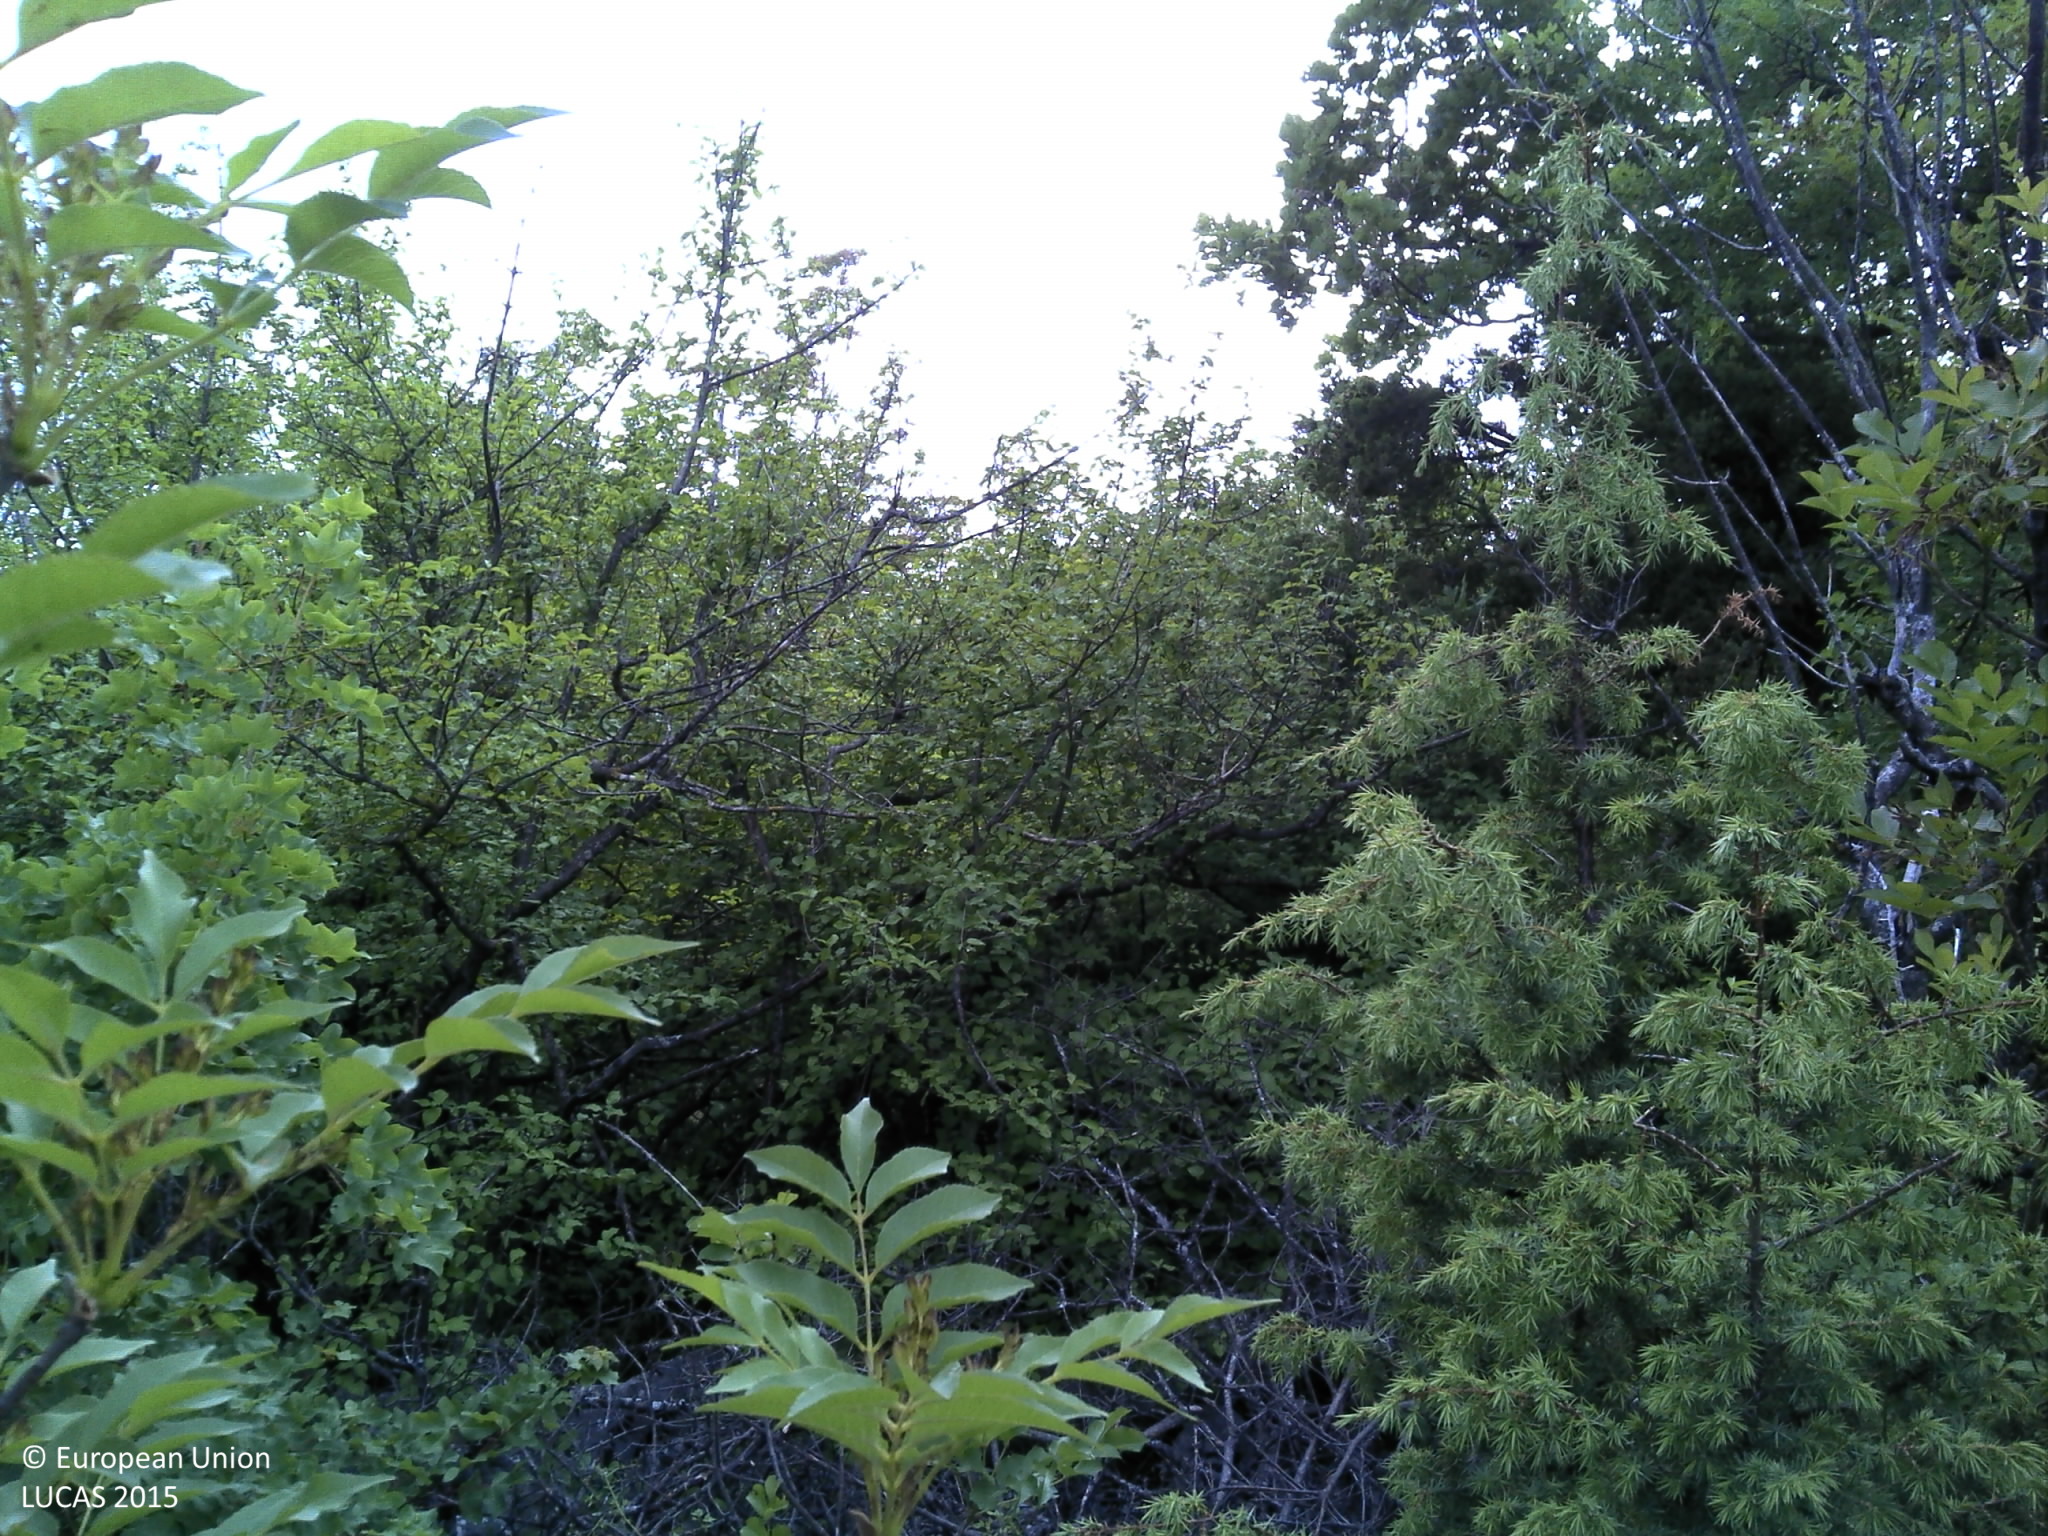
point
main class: Woodland
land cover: Broadleaved woodland
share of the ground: 25 - 50 %
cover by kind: shrubs 40 %, herbaceous plants 30 %, broadleaved forest trees 25 %, coniferous forest trees 5 %
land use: Semi-natural and natural areas not in use
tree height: < 5 m
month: May
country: HR
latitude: 44.0164
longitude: 16.2671
